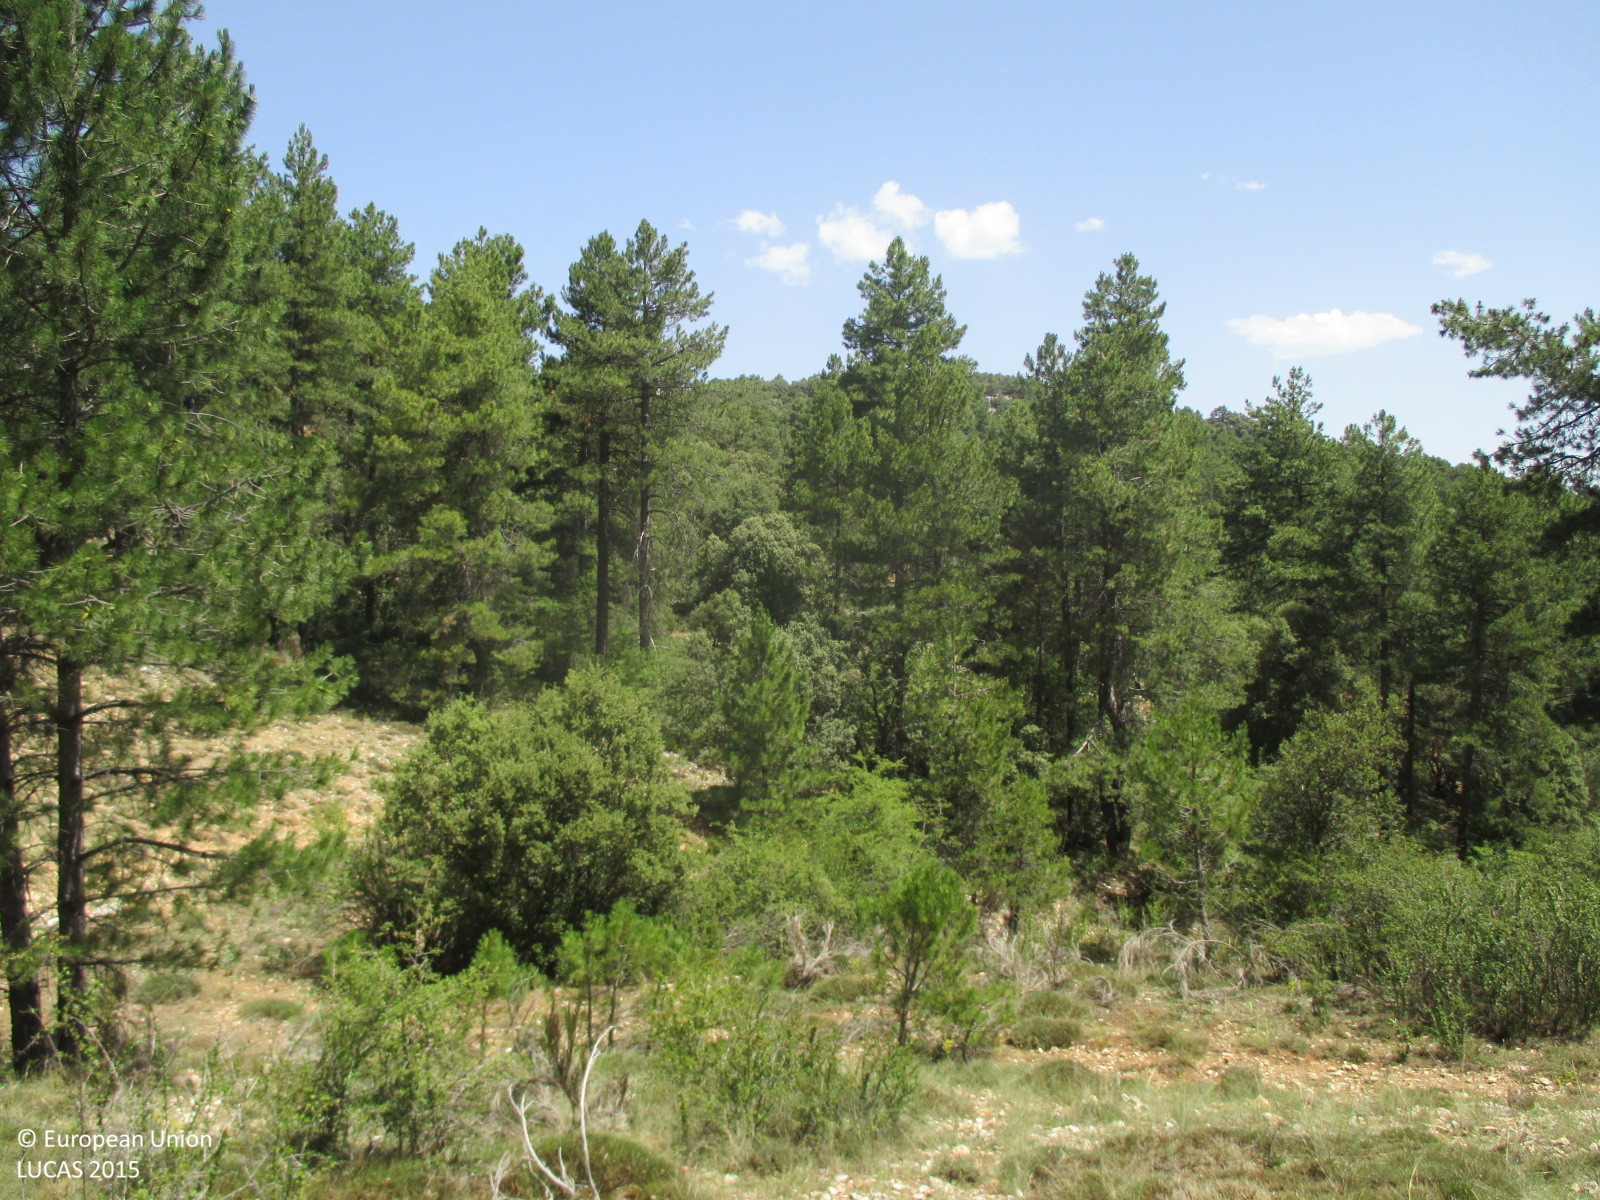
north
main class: Woodland
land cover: Pine dominated mixed woodland
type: coniferous forest of the mediterranean region
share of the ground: 25 - 50 %
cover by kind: herbaceous plants 70 %, coniferous forest trees 20 %, broadleaved forest trees 10 %
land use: Forestry
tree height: > 5 m
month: July
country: ES
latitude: 38.0530
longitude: -2.5175
